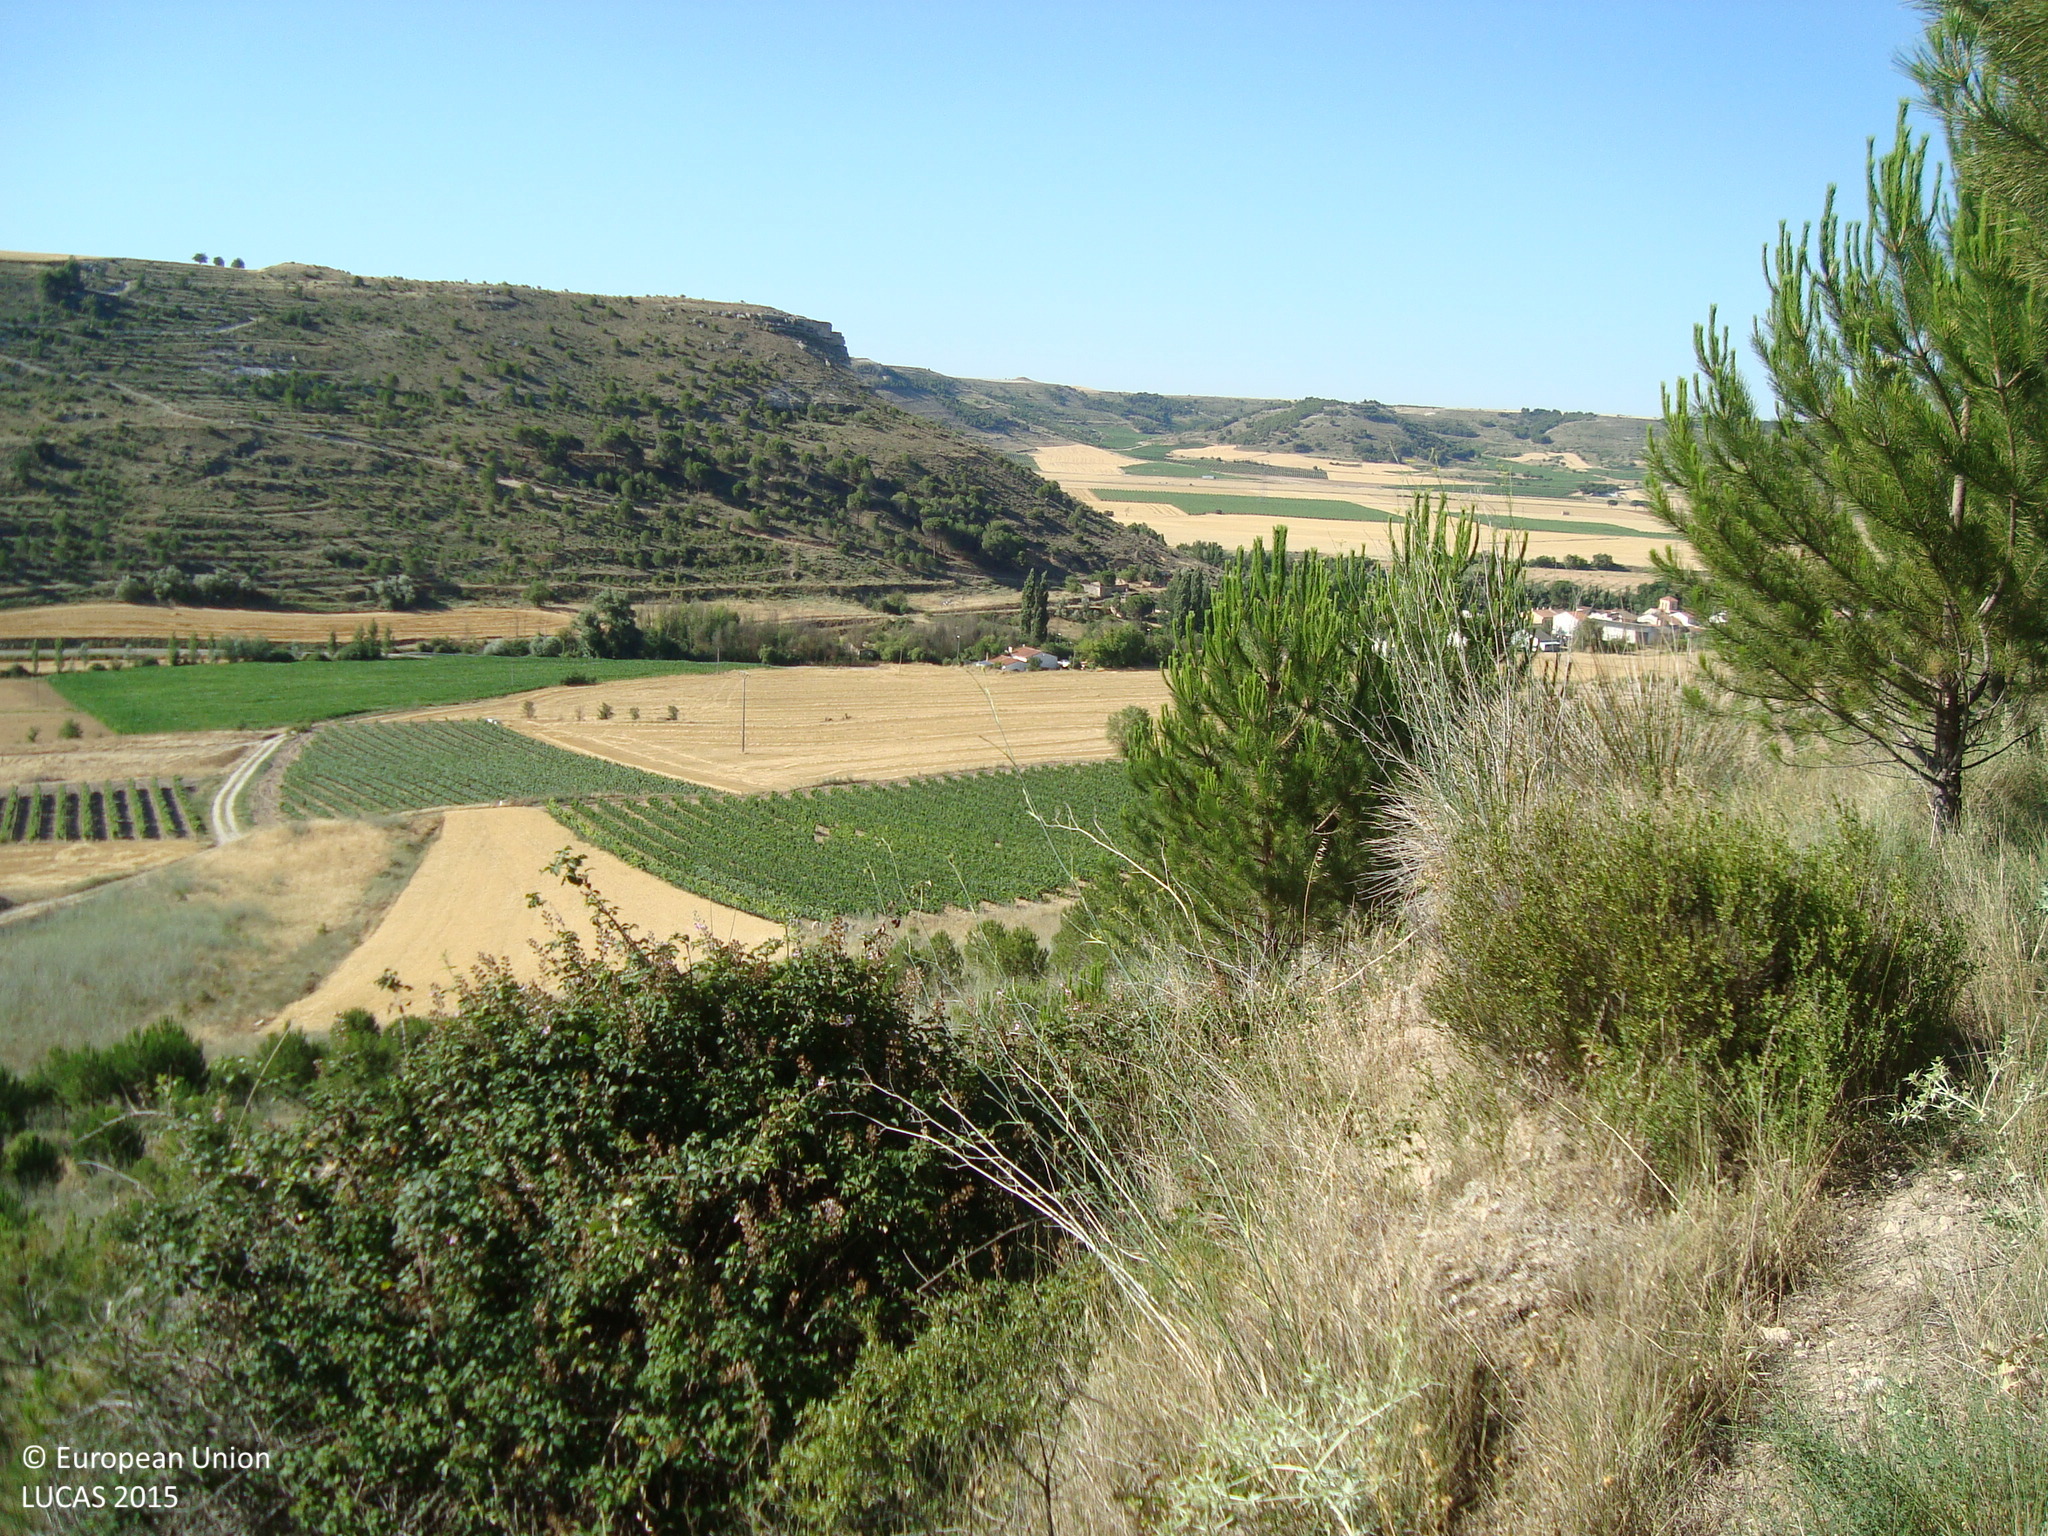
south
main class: Woodland
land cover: Pine dominated coniferous woodland
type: coniferous forest of the mediterranean region
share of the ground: 50 - 75 %
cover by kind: coniferous forest trees 60 %, shrubs 20 %, herbaceous plants 10 %, unconsolidated bare surface 10 %
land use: Forestry
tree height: > 5 m
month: July
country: ES
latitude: 41.6303
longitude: -4.0661
